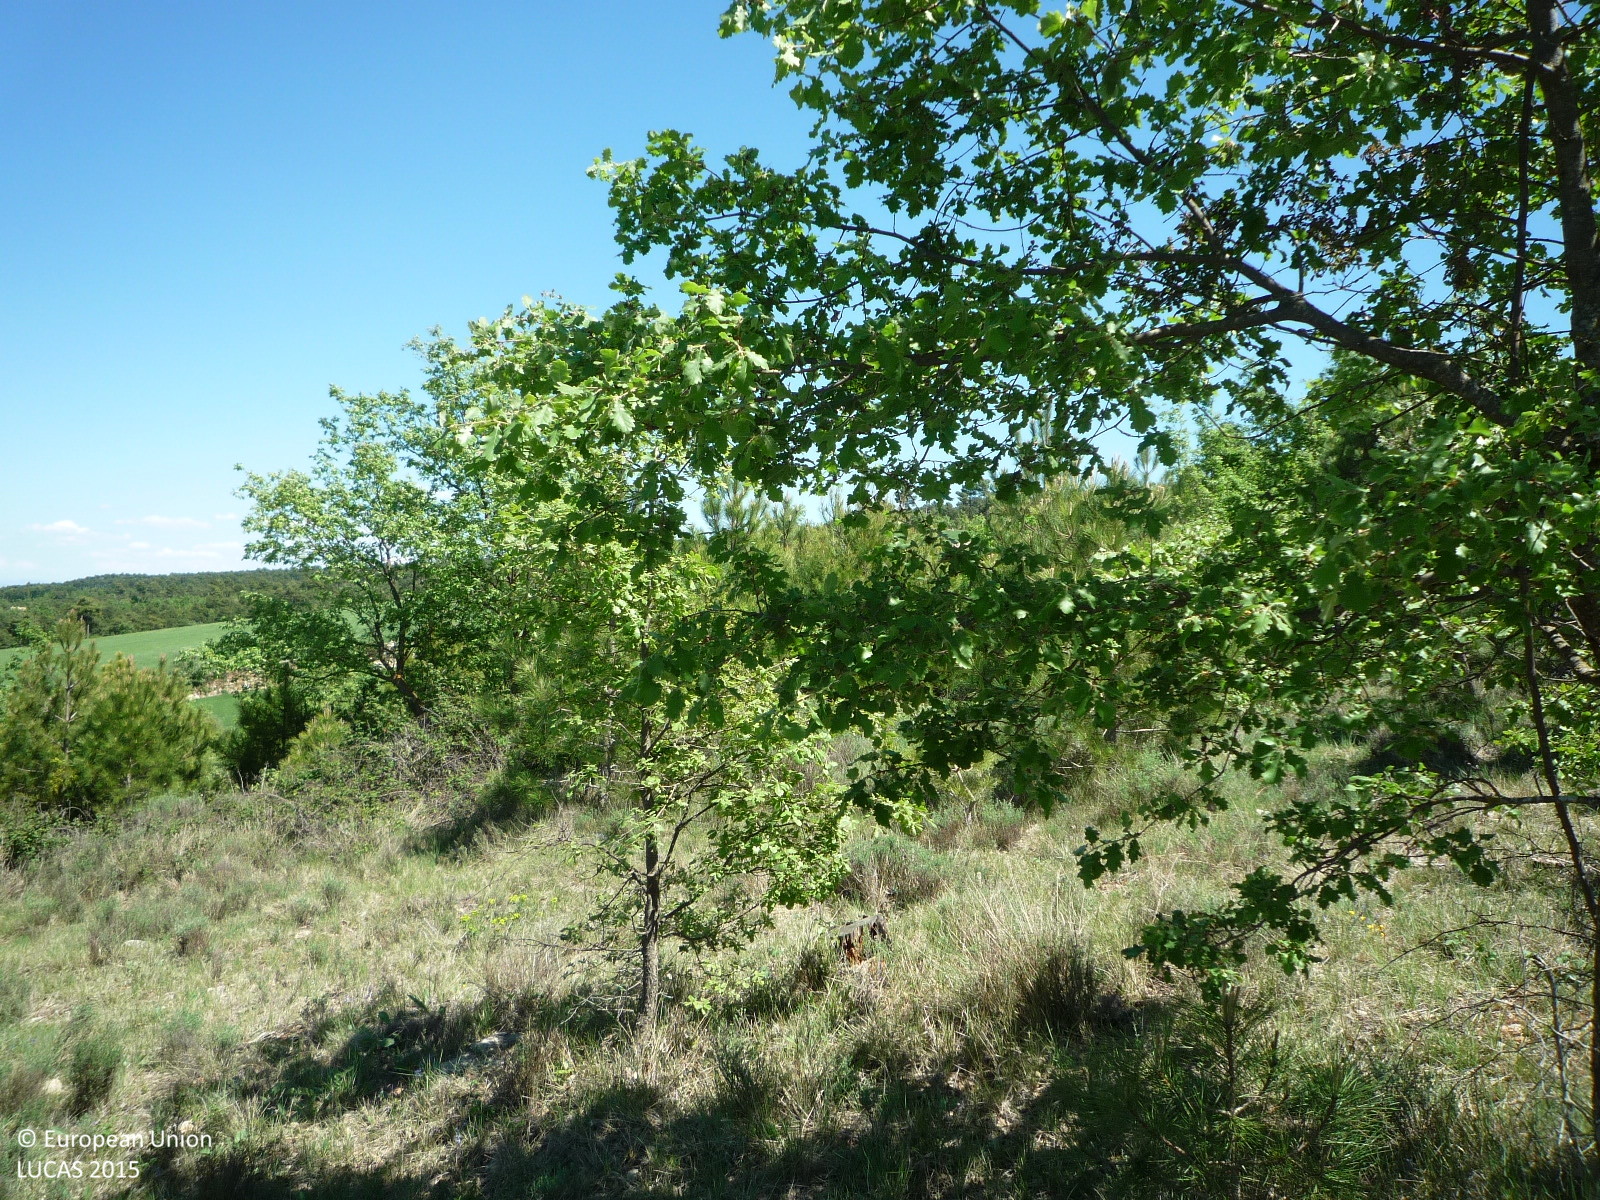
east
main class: Woodland
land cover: Other mixed woodland
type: broadleaved evergreen forest
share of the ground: > 75 %
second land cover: Spontaneously vegetated surfaces
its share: 25 - 50 %
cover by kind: herbaceous plants 40 %, broadleaved forest trees 35 %, coniferous forest trees 25 %
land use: Forestry
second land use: Agriculture (excluding fallow land and kitchen gardens)
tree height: < 5 m
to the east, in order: Other mixed woodland; Spontaneously vegetated surfaces; Grassland with sparse tree/shrub cover; Fences; Pine dominated coniferous woodland; Dry stone walls; Tracks; Shruby margins; Grassland without tree/shrub cover; Shrubland with sparse tree cover; Barley; Dry stone walls; Grassland without tree/shrub cover; Barley
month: May
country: ES
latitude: 41.7965
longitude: 1.6020
